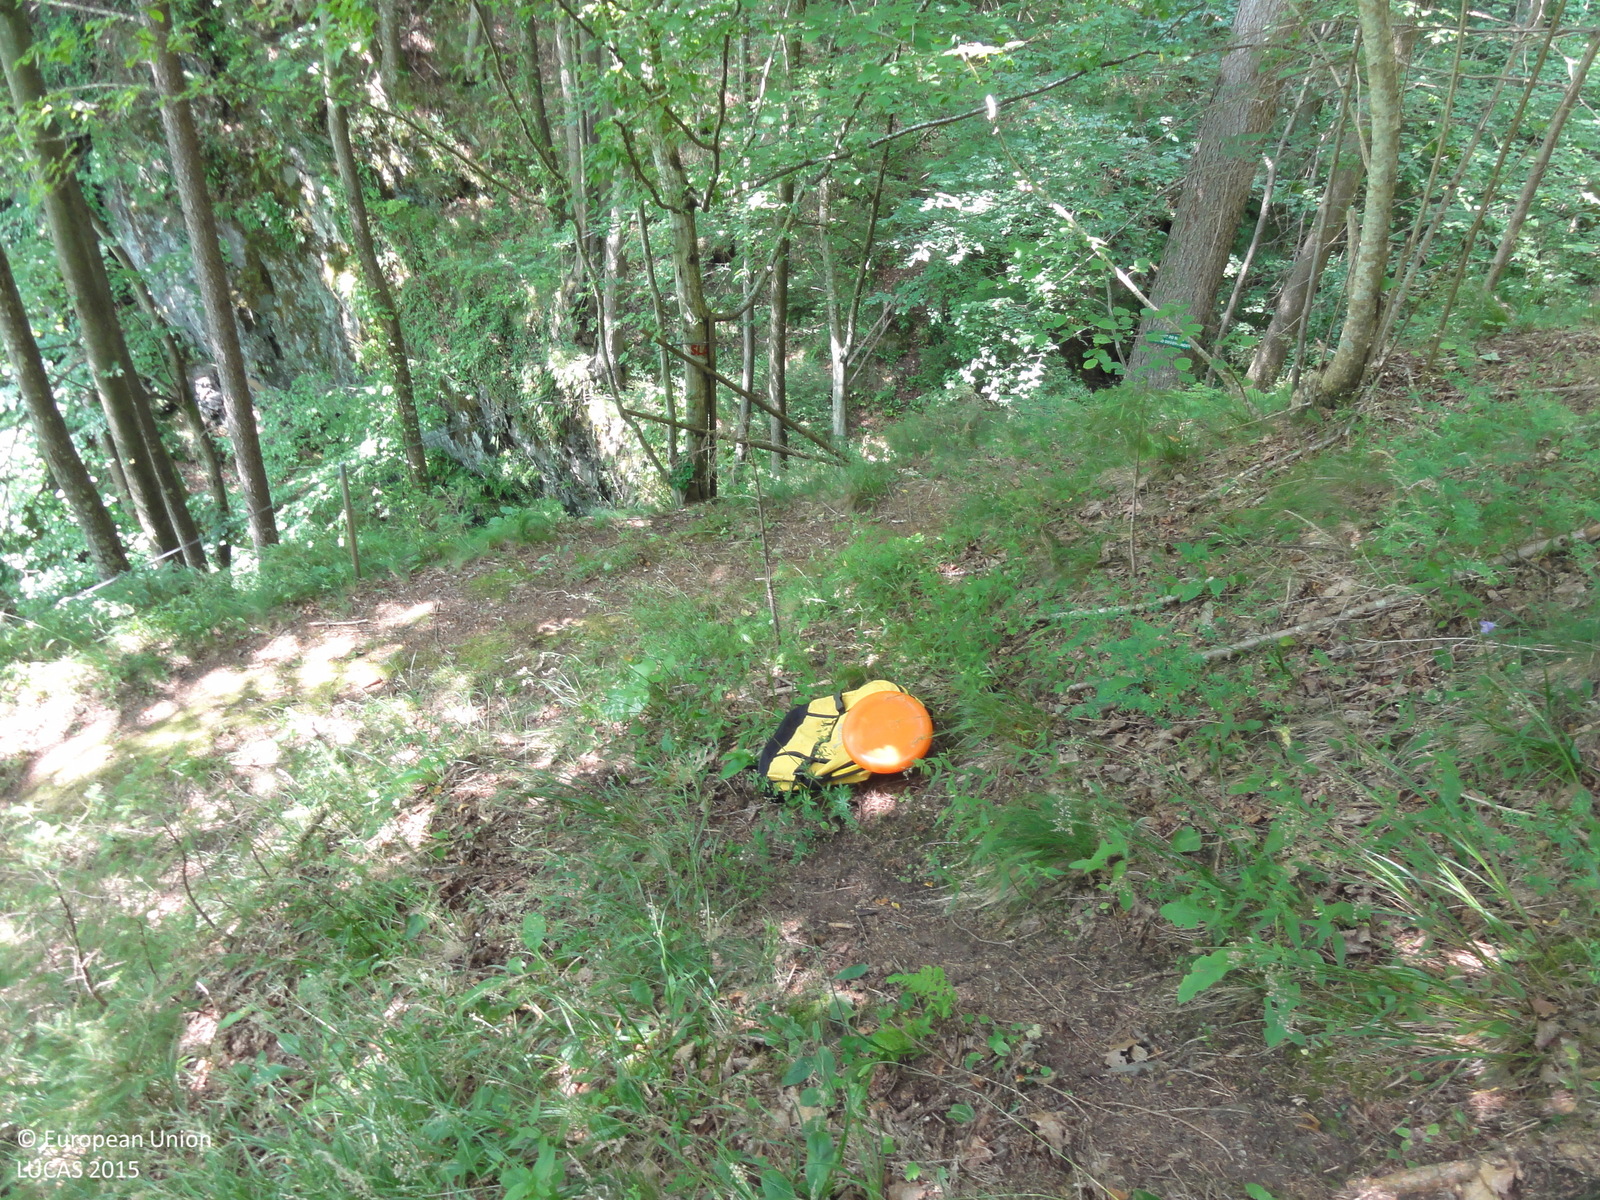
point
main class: Woodland
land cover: Spruce dominated mixed woodland
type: beech forest
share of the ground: > 75 %
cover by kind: broadleaved forest trees 75 %, coniferous forest trees 25 %
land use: Forestry
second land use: Amenities, museums, leisure
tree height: > 5 m
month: July
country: SI
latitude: 46.6431
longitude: 15.1327
